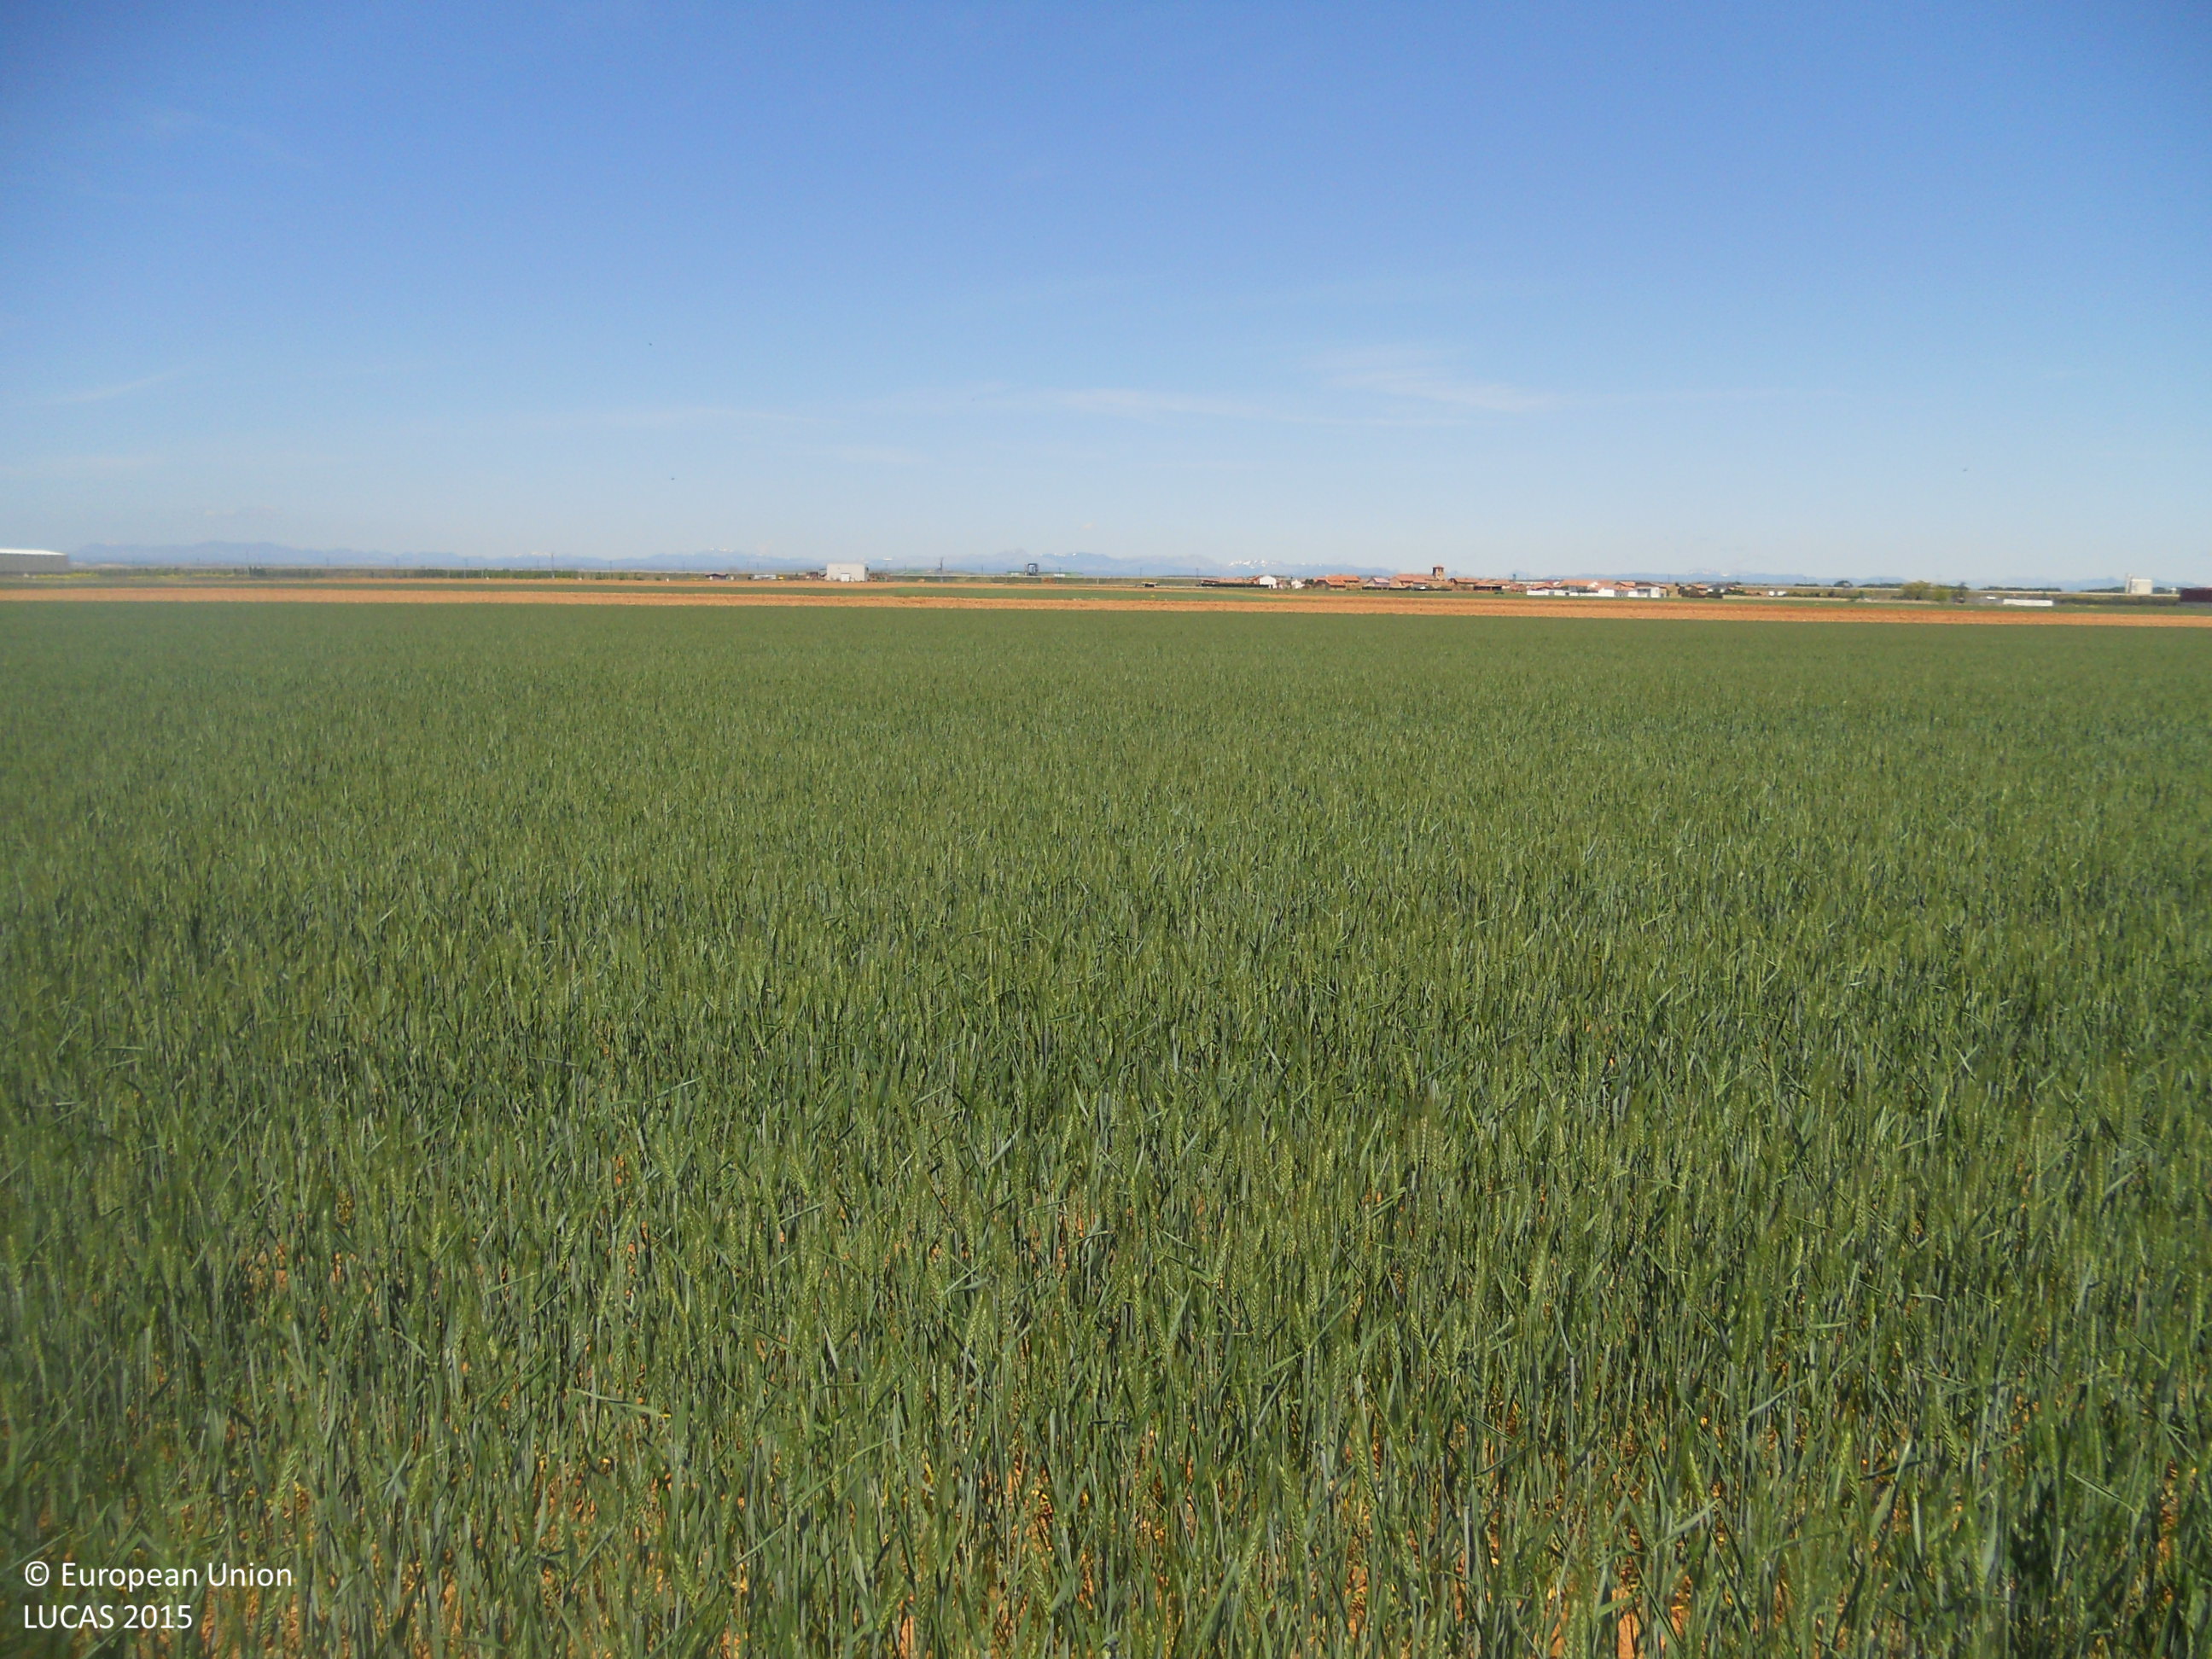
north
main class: Cropland
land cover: Durum wheat
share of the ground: > 75 %
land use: Agriculture (excluding fallow land and kitchen gardens)
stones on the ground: < 10 %
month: May
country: ES
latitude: 42.4411
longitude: -5.3974
